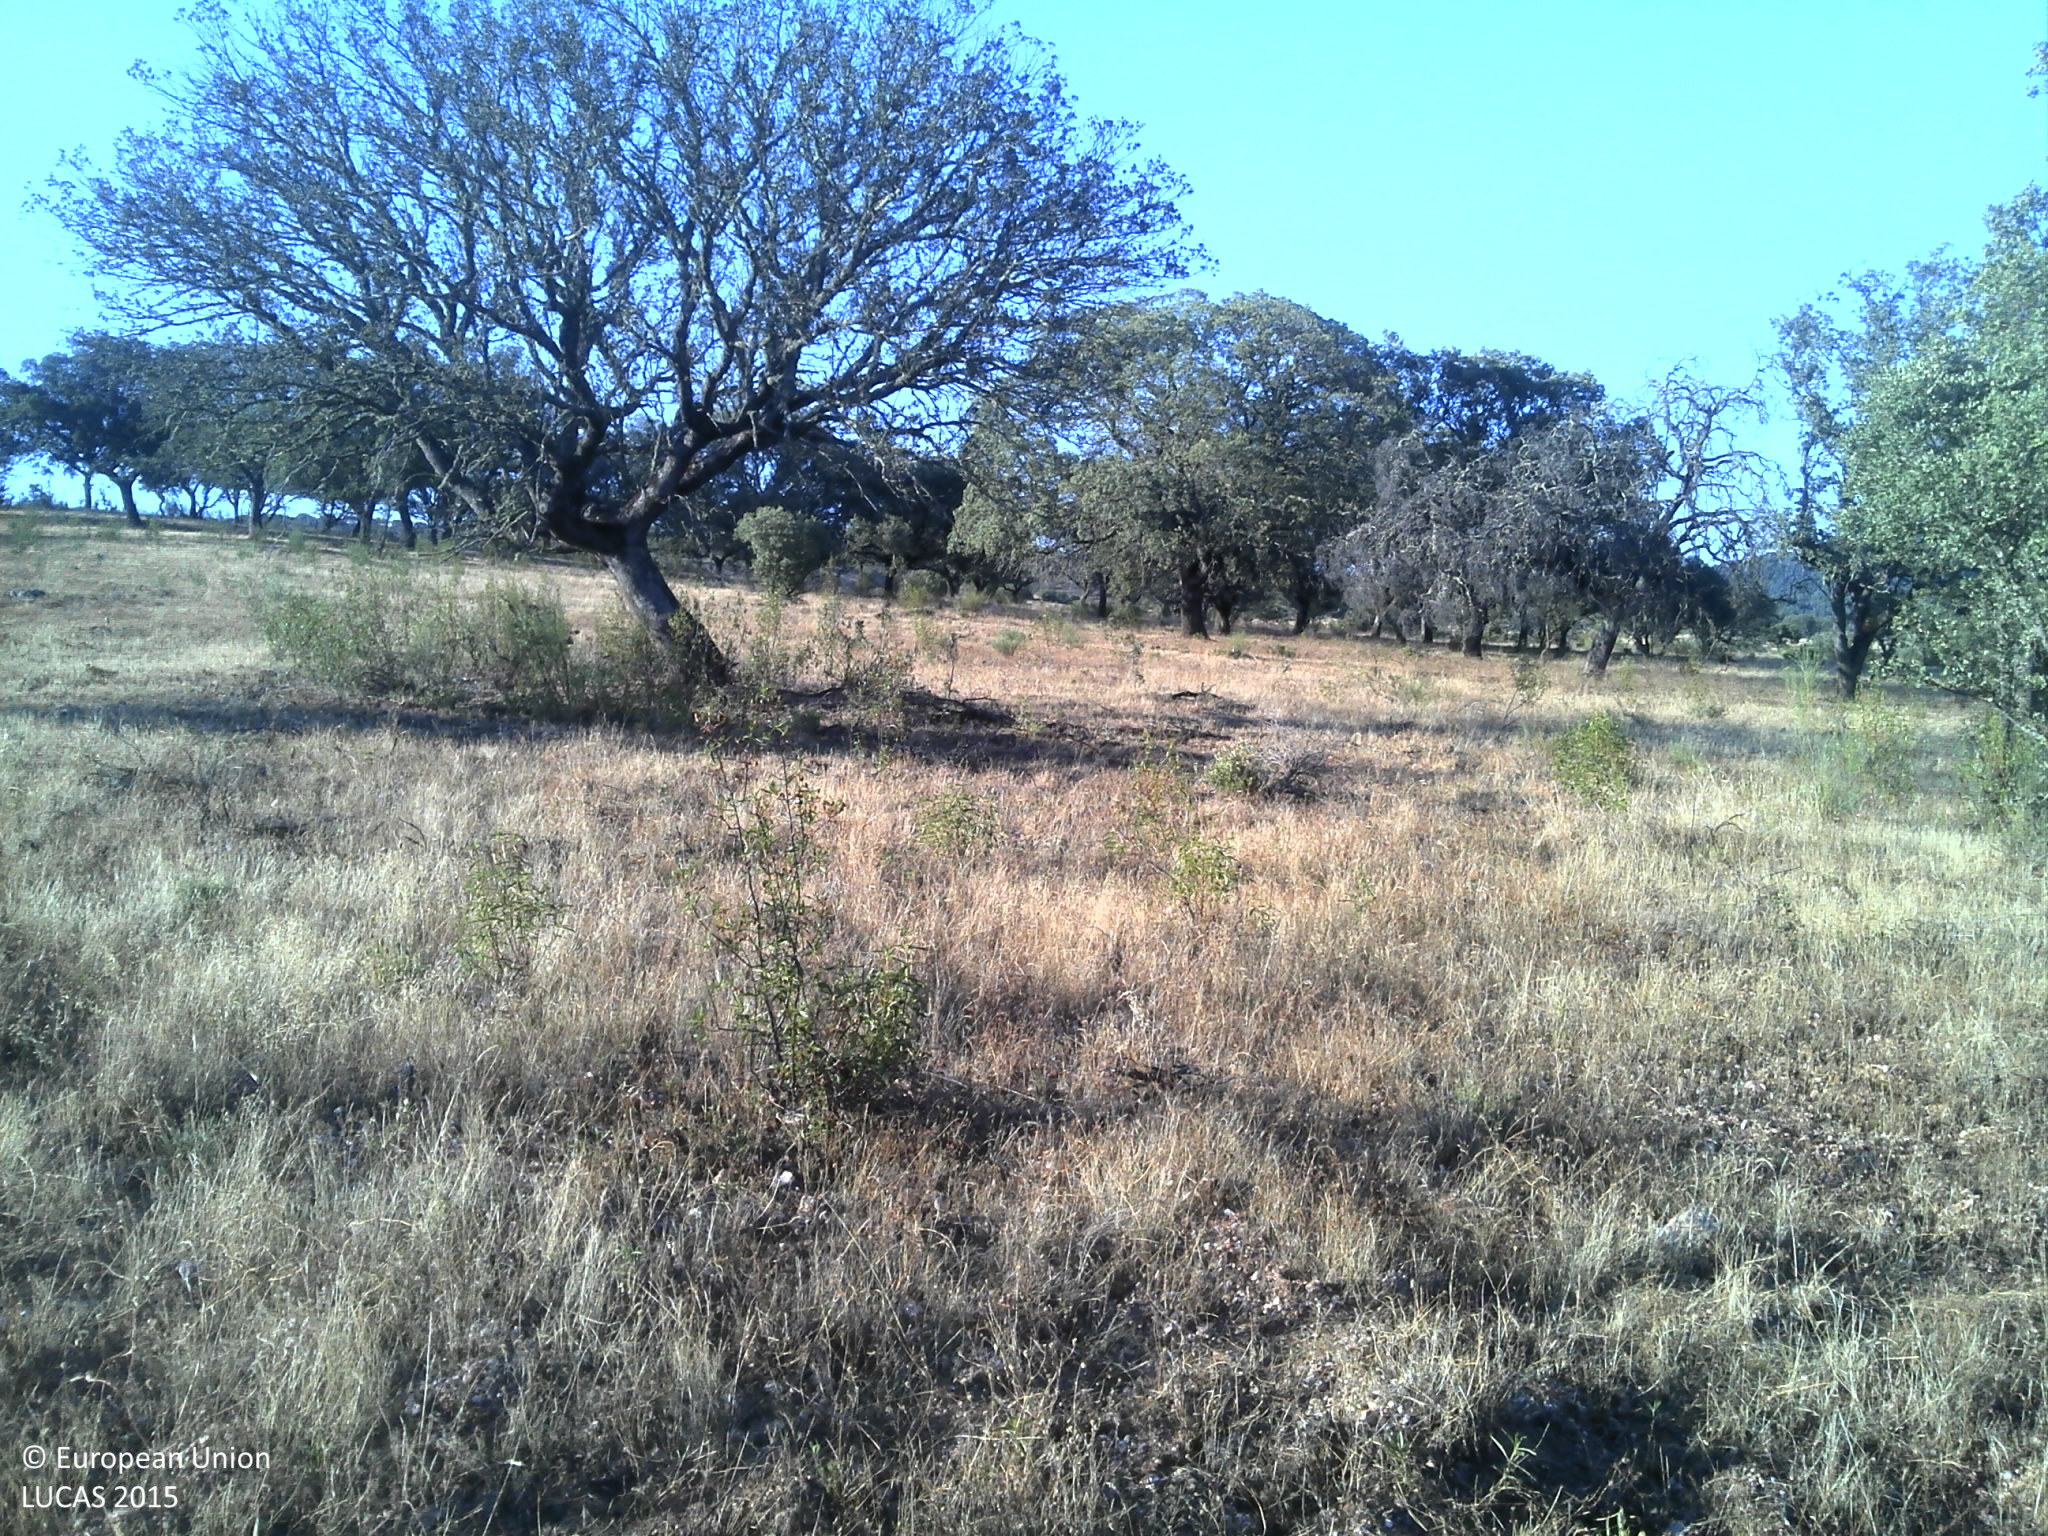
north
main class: Grassland
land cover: Grassland with sparse tree/shrub cover
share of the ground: 25 - 50 %
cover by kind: unconsolidated bare surface 45 %, herbaceous plants 40 %, broadleaved forest trees 5 %, shrubs 5 %
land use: Agriculture (excluding fallow land and kitchen gardens)
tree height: > 5 m
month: June
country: PT
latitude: 39.9388
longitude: -7.0719
